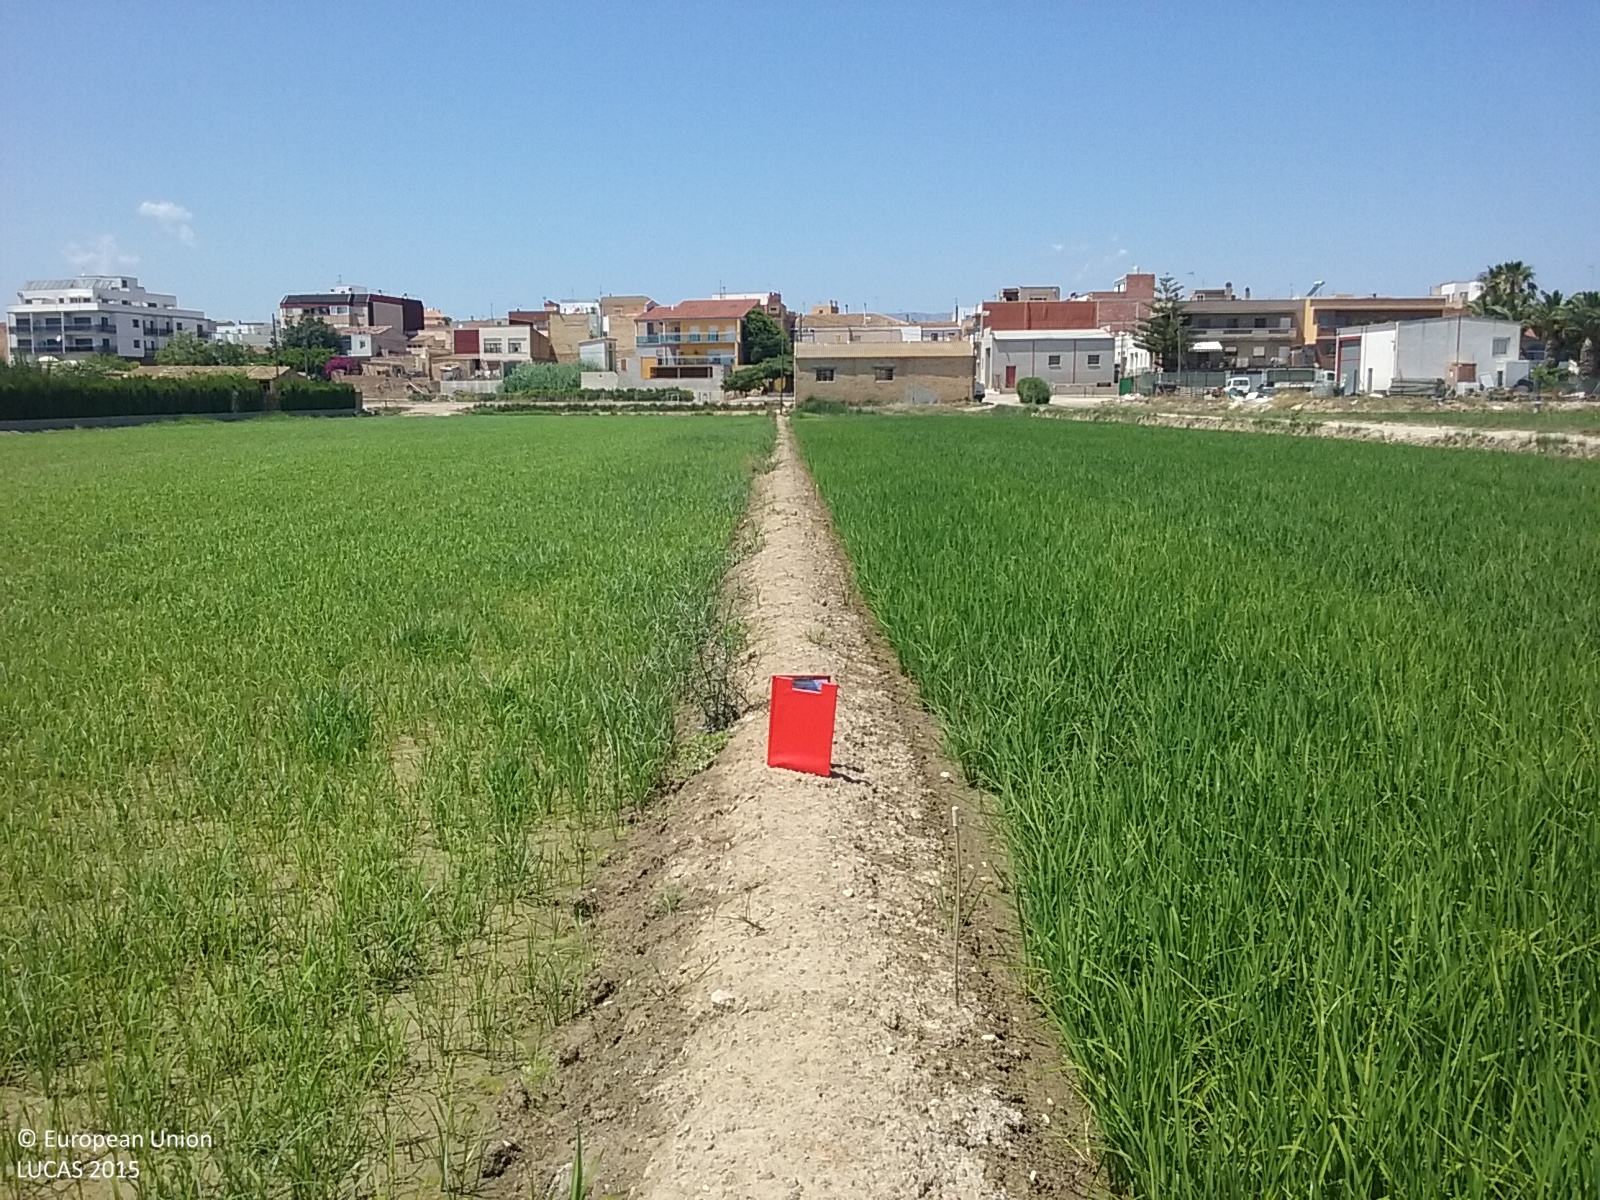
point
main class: Cropland
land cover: Rice
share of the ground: 50 - 75 %
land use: Agriculture (excluding fallow land and kitchen gardens)
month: June
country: ES
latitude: 40.7682
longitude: 0.6711
